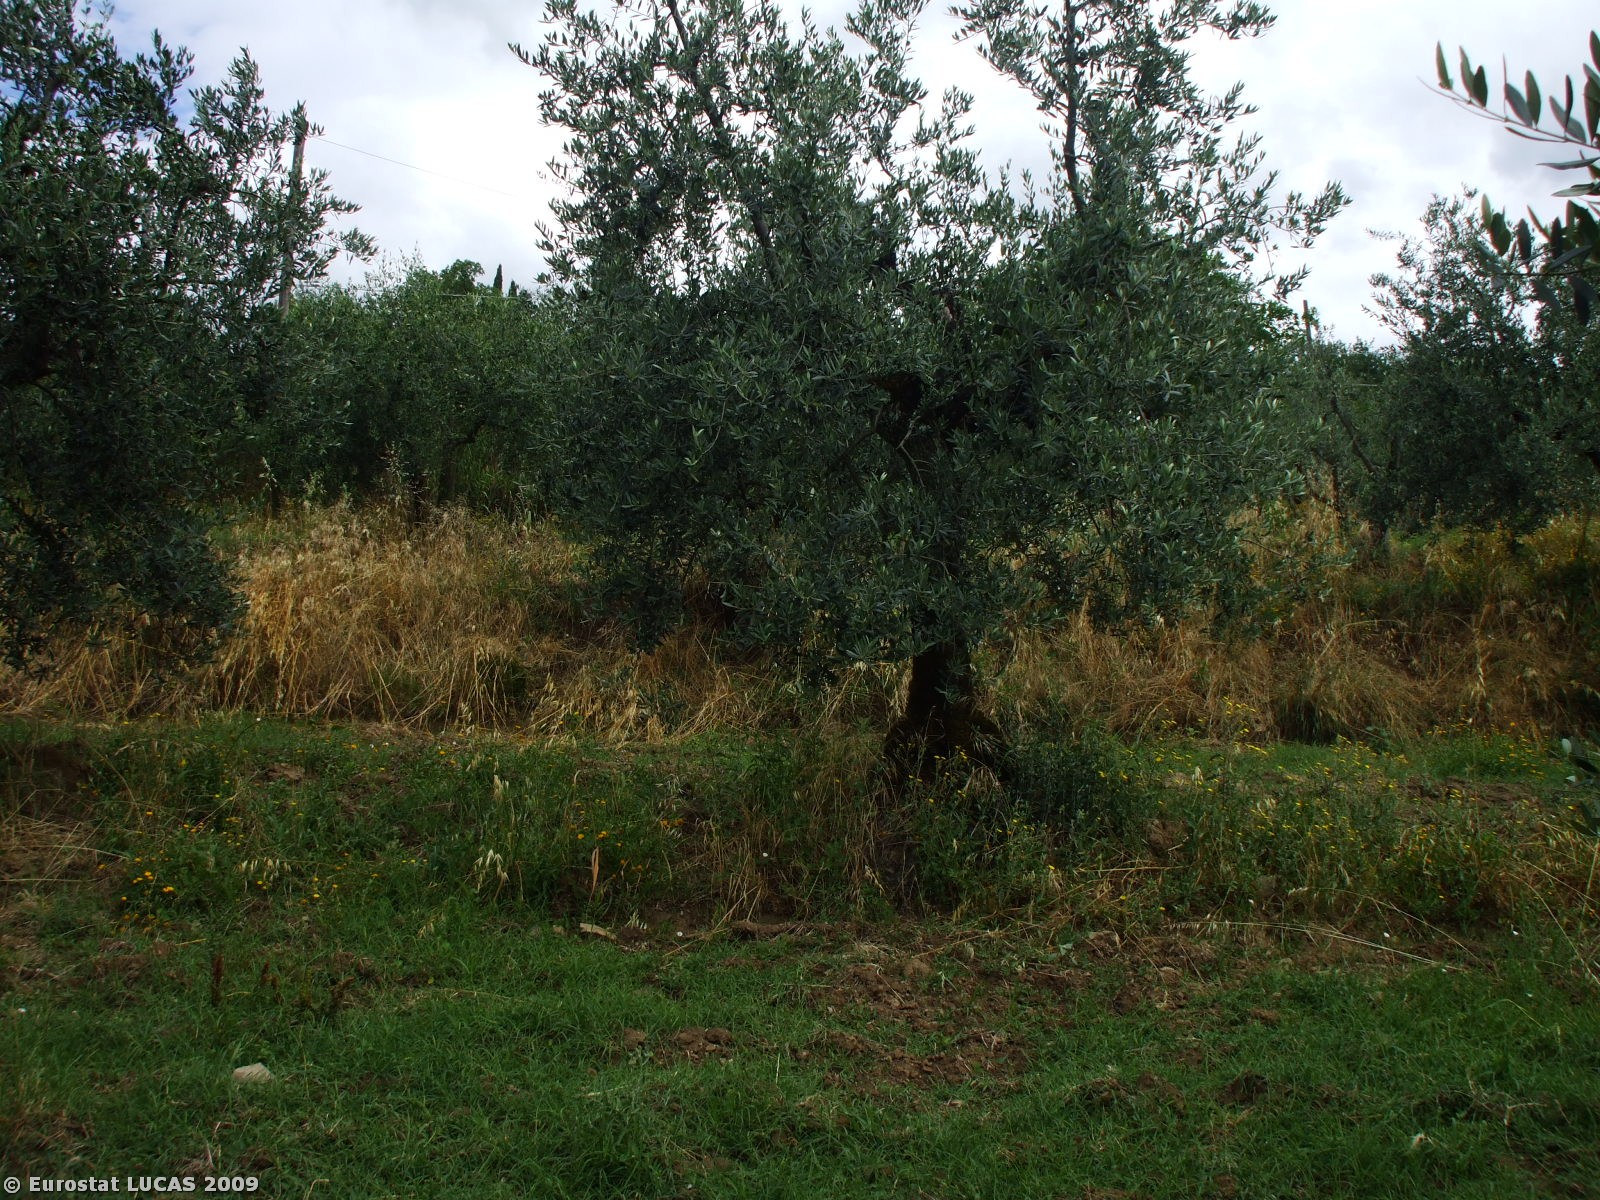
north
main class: Cropland
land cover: Olive groves
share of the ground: 10 - 25 %
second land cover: Spontaneously vegetated surfaces
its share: > 75 %
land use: Agriculture (excluding fallow land and kitchen gardens)
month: June
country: IT
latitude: 43.5612
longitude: 11.6668
